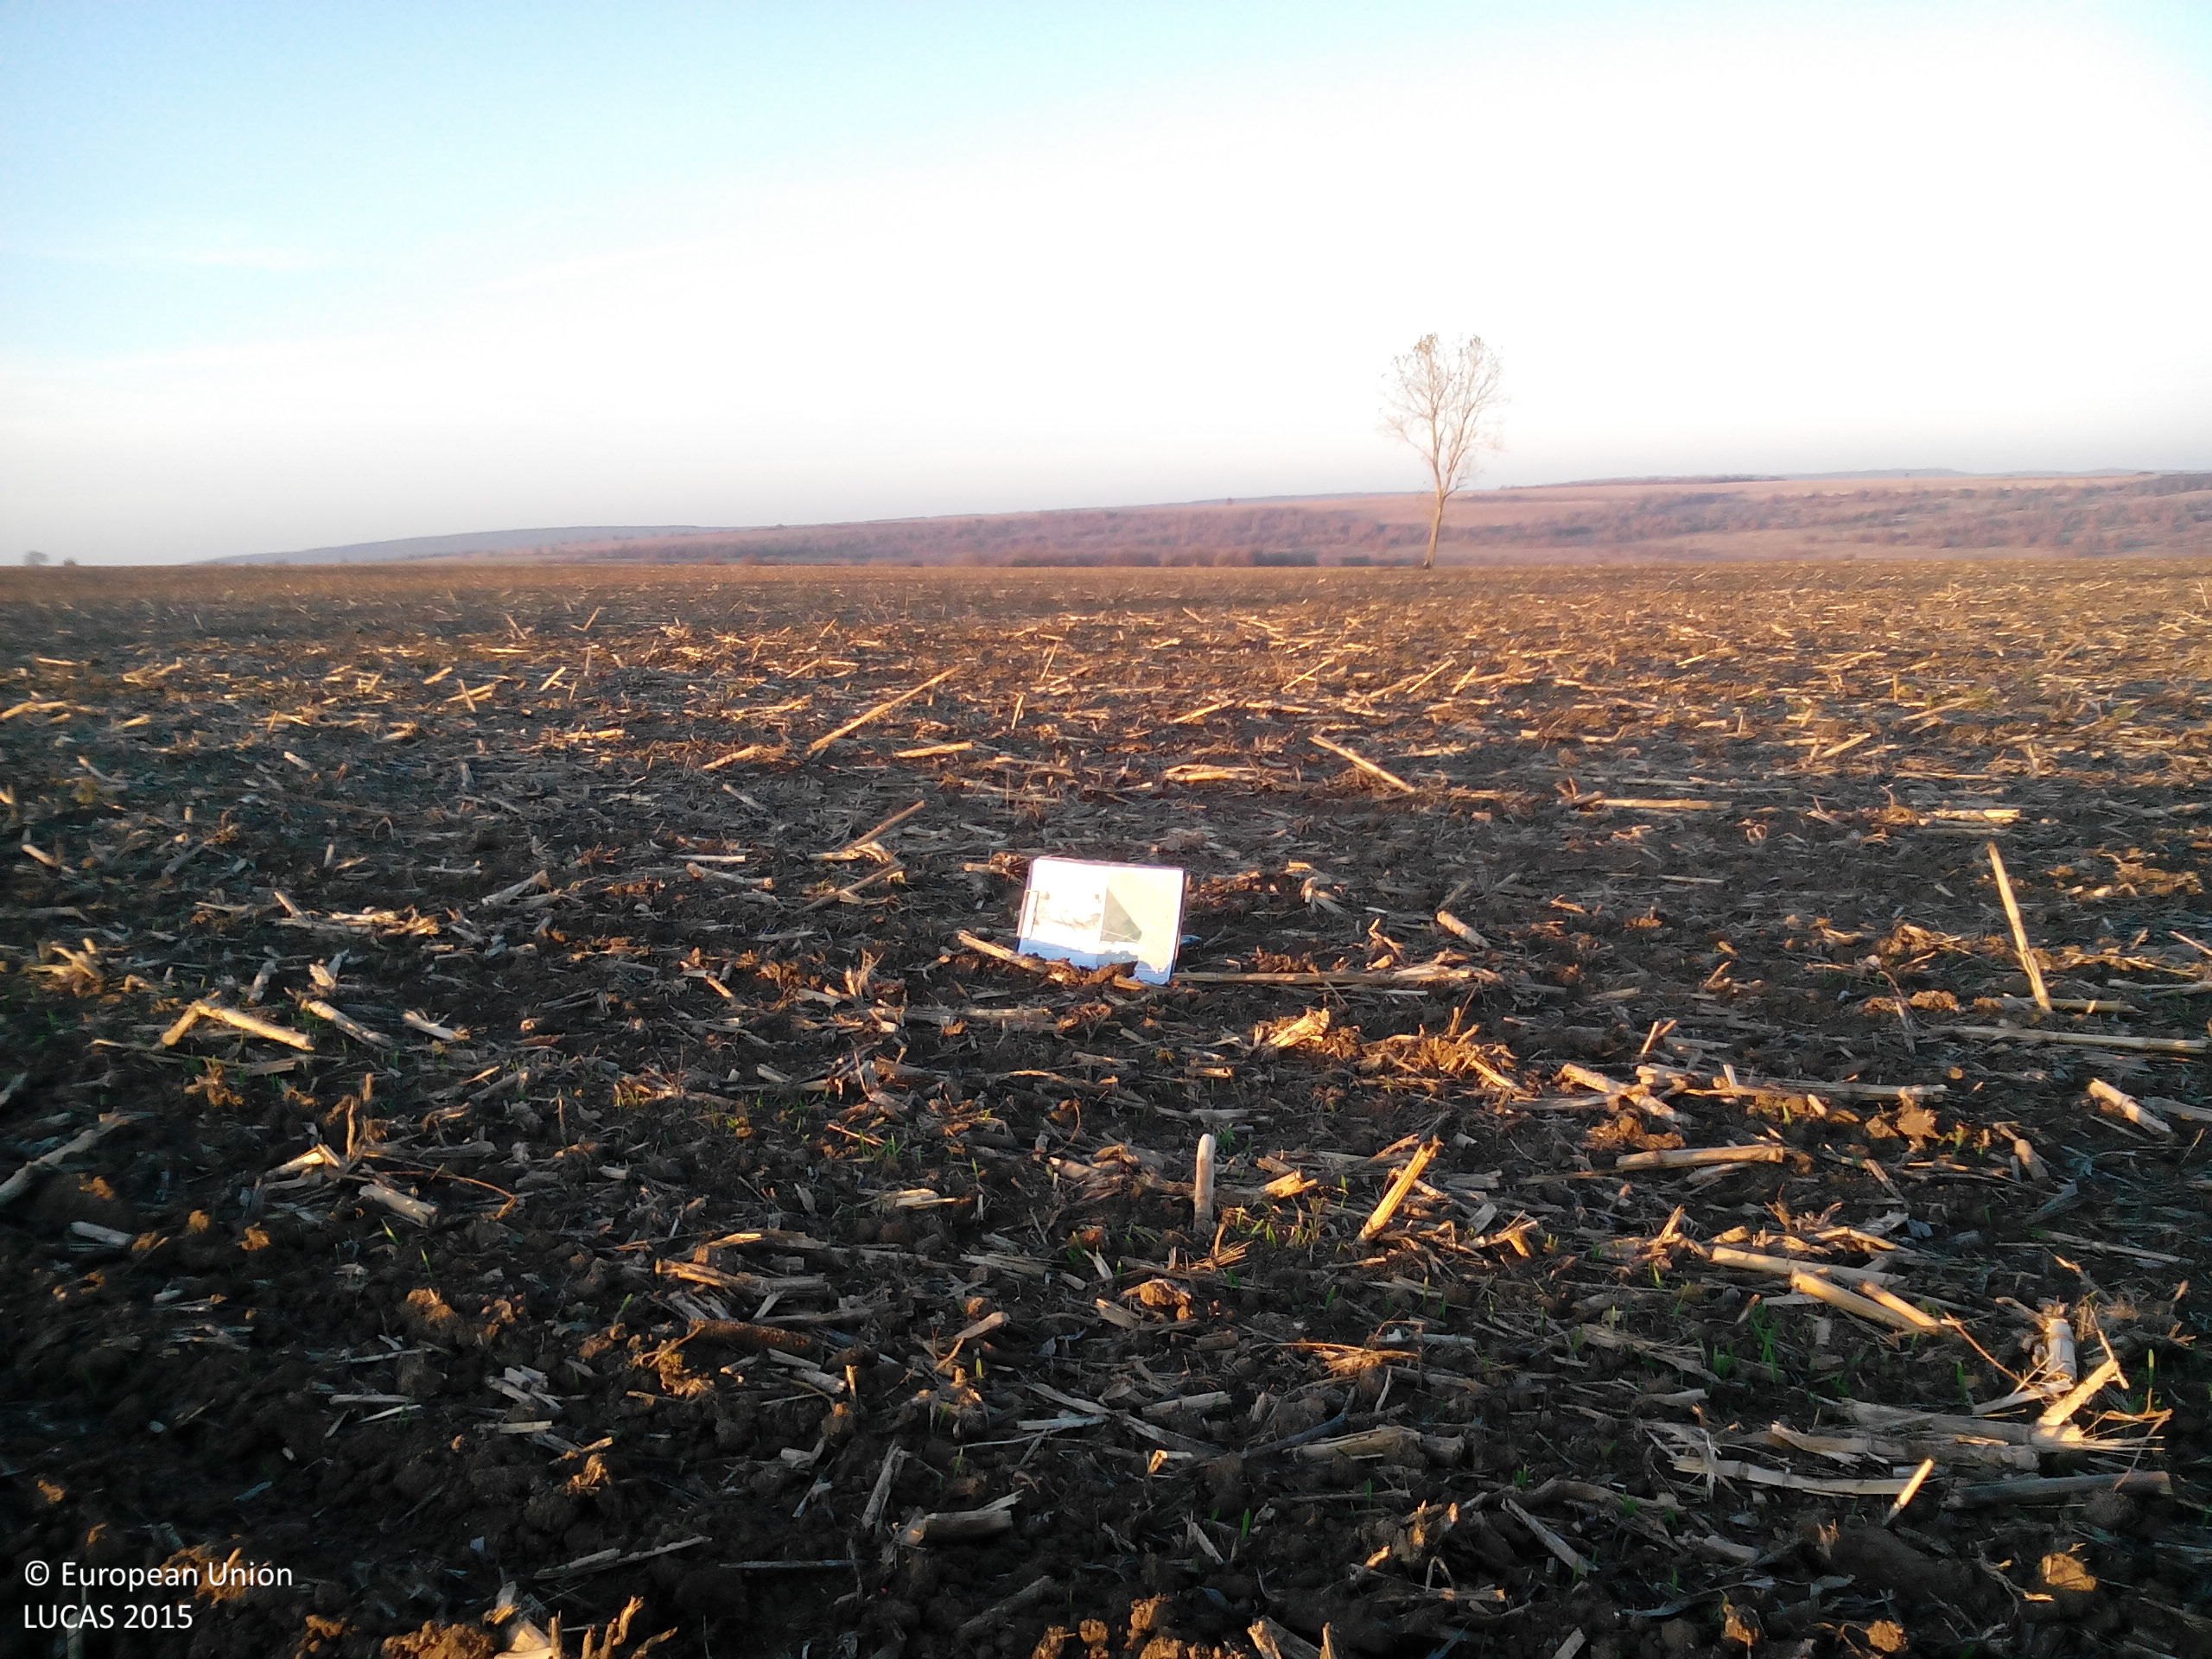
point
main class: Cropland
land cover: Maize
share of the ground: < 10 %
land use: Agriculture (excluding fallow land and kitchen gardens)
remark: Harvested field
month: November
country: BG
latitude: 43.2380
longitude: 23.9523
